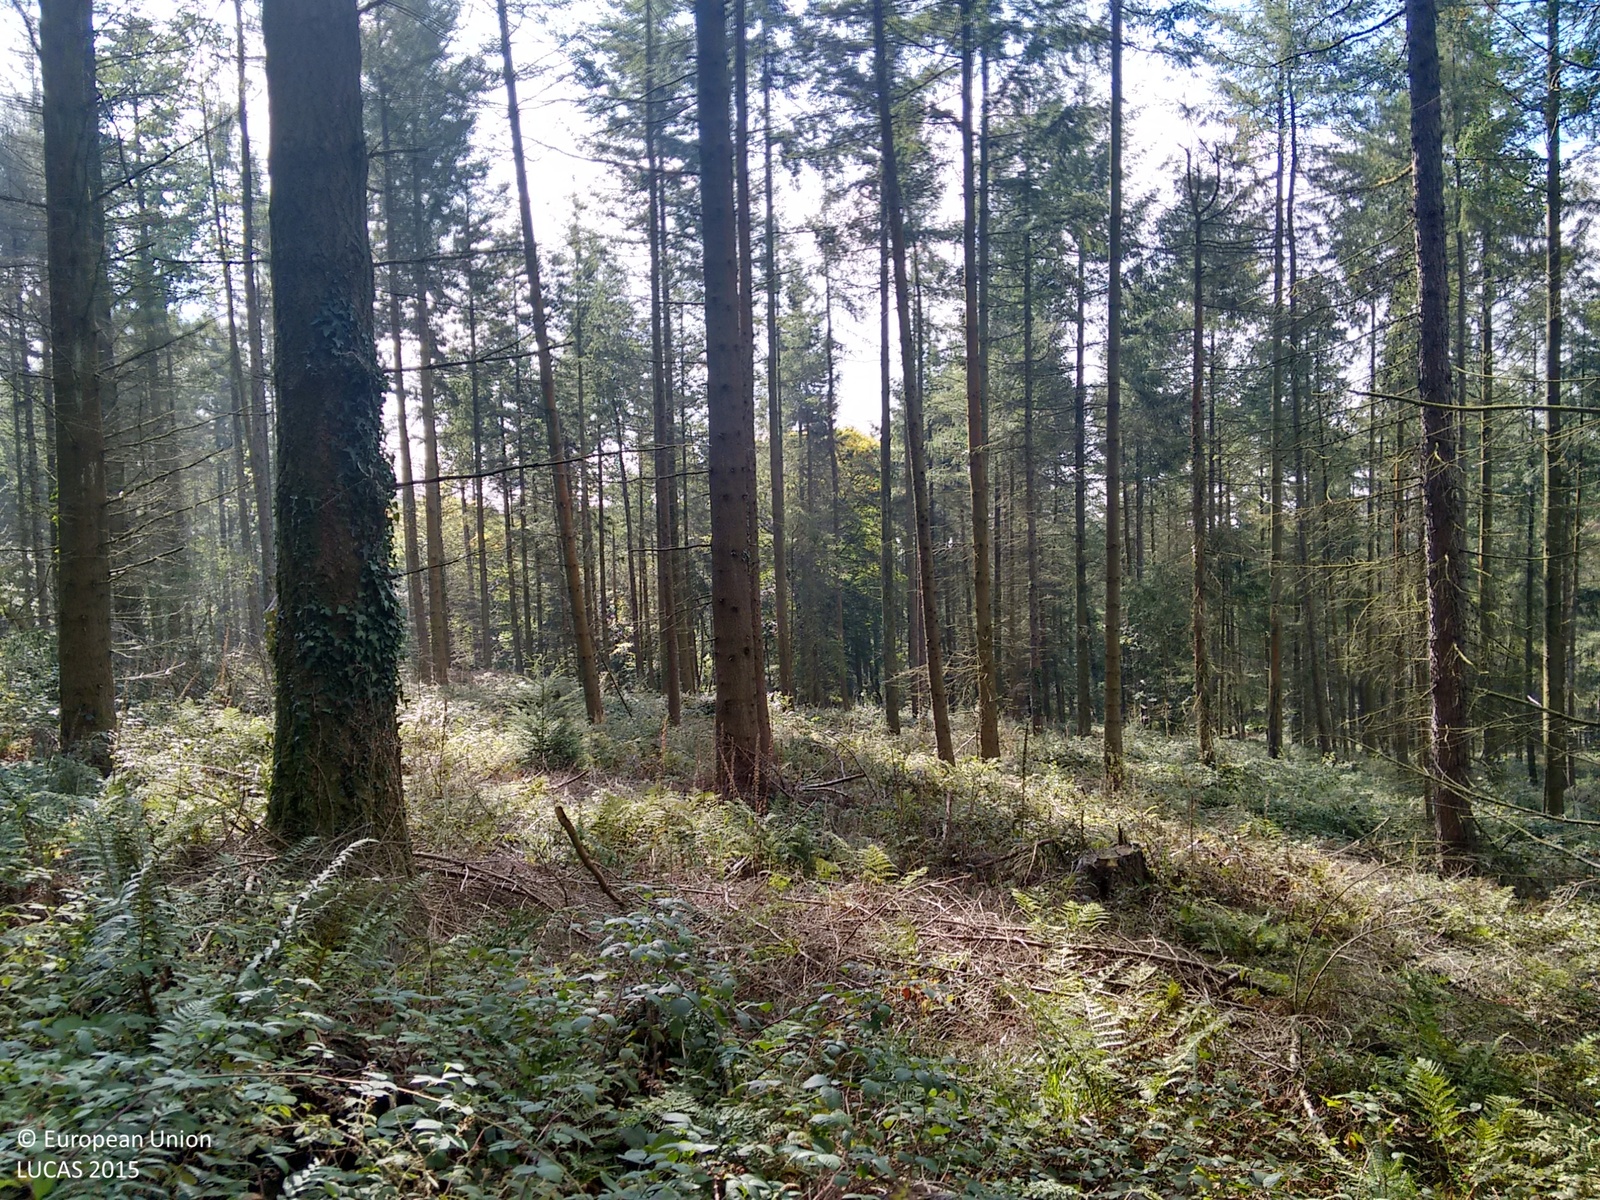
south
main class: Woodland
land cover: Spruce dominated coniferous woodland
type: exotic forest
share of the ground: > 75 %
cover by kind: coniferous forest trees 65 %, shrubs 35 %
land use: Forestry
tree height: > 5 m
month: October
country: GB
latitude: 51.6378
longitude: -2.8602
